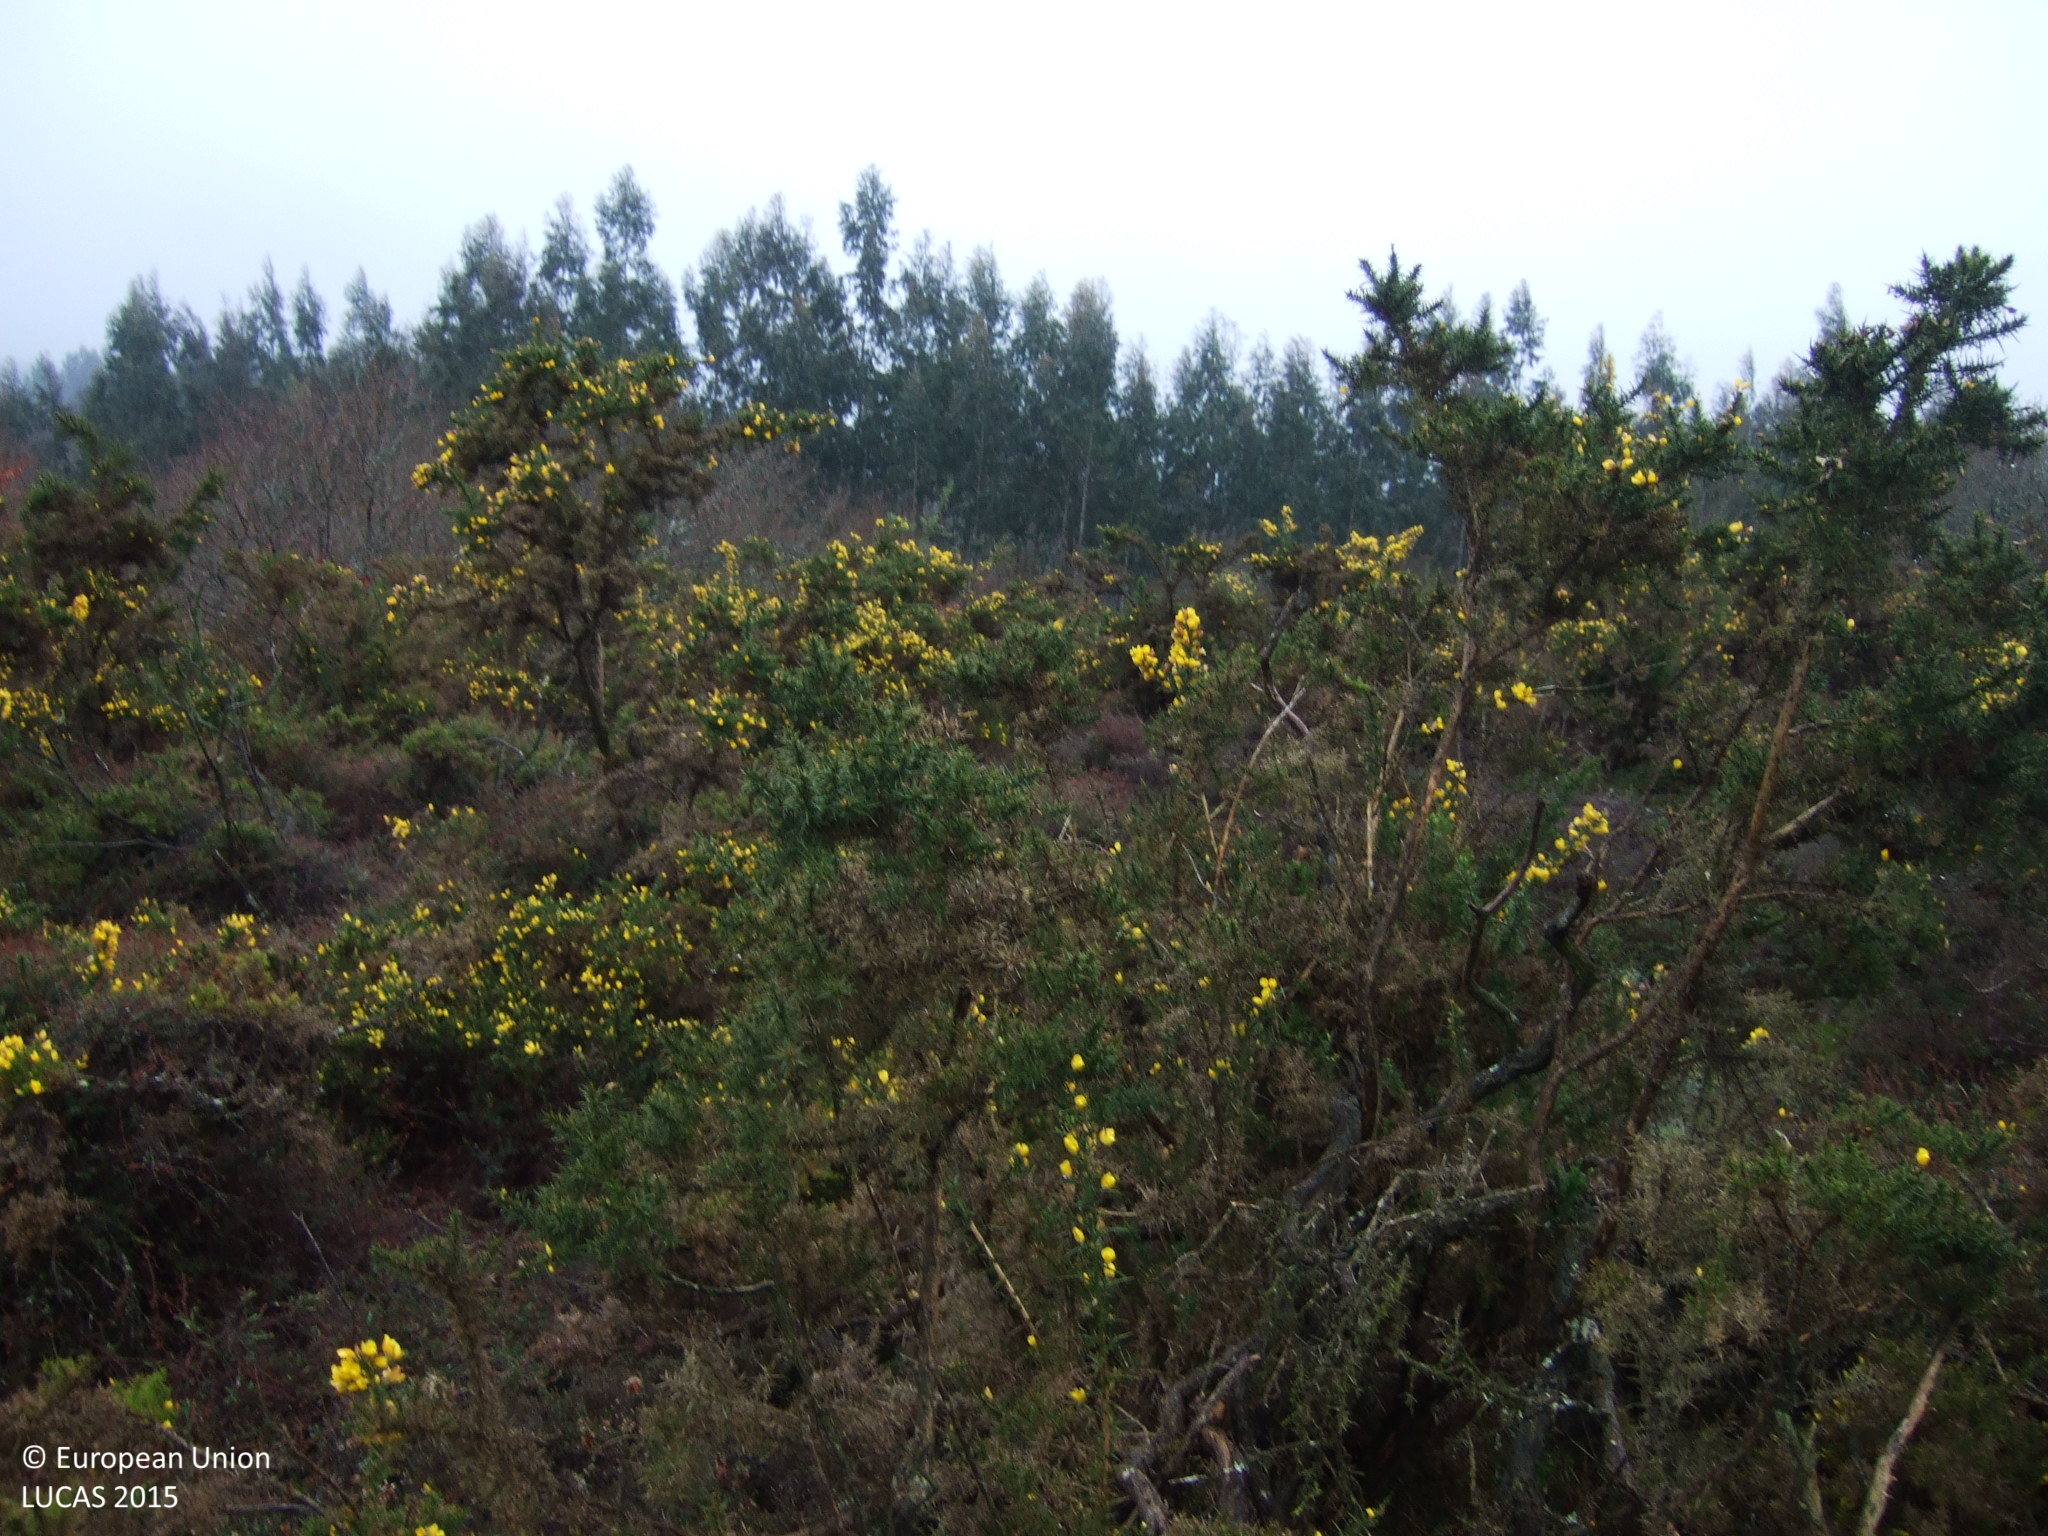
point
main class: Shrubland
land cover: Shrubland without tree cover
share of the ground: > 75 %
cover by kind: shrubs 100 %
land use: Semi-natural and natural areas not in use
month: March
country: ES
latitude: 42.8624
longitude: -7.8429
